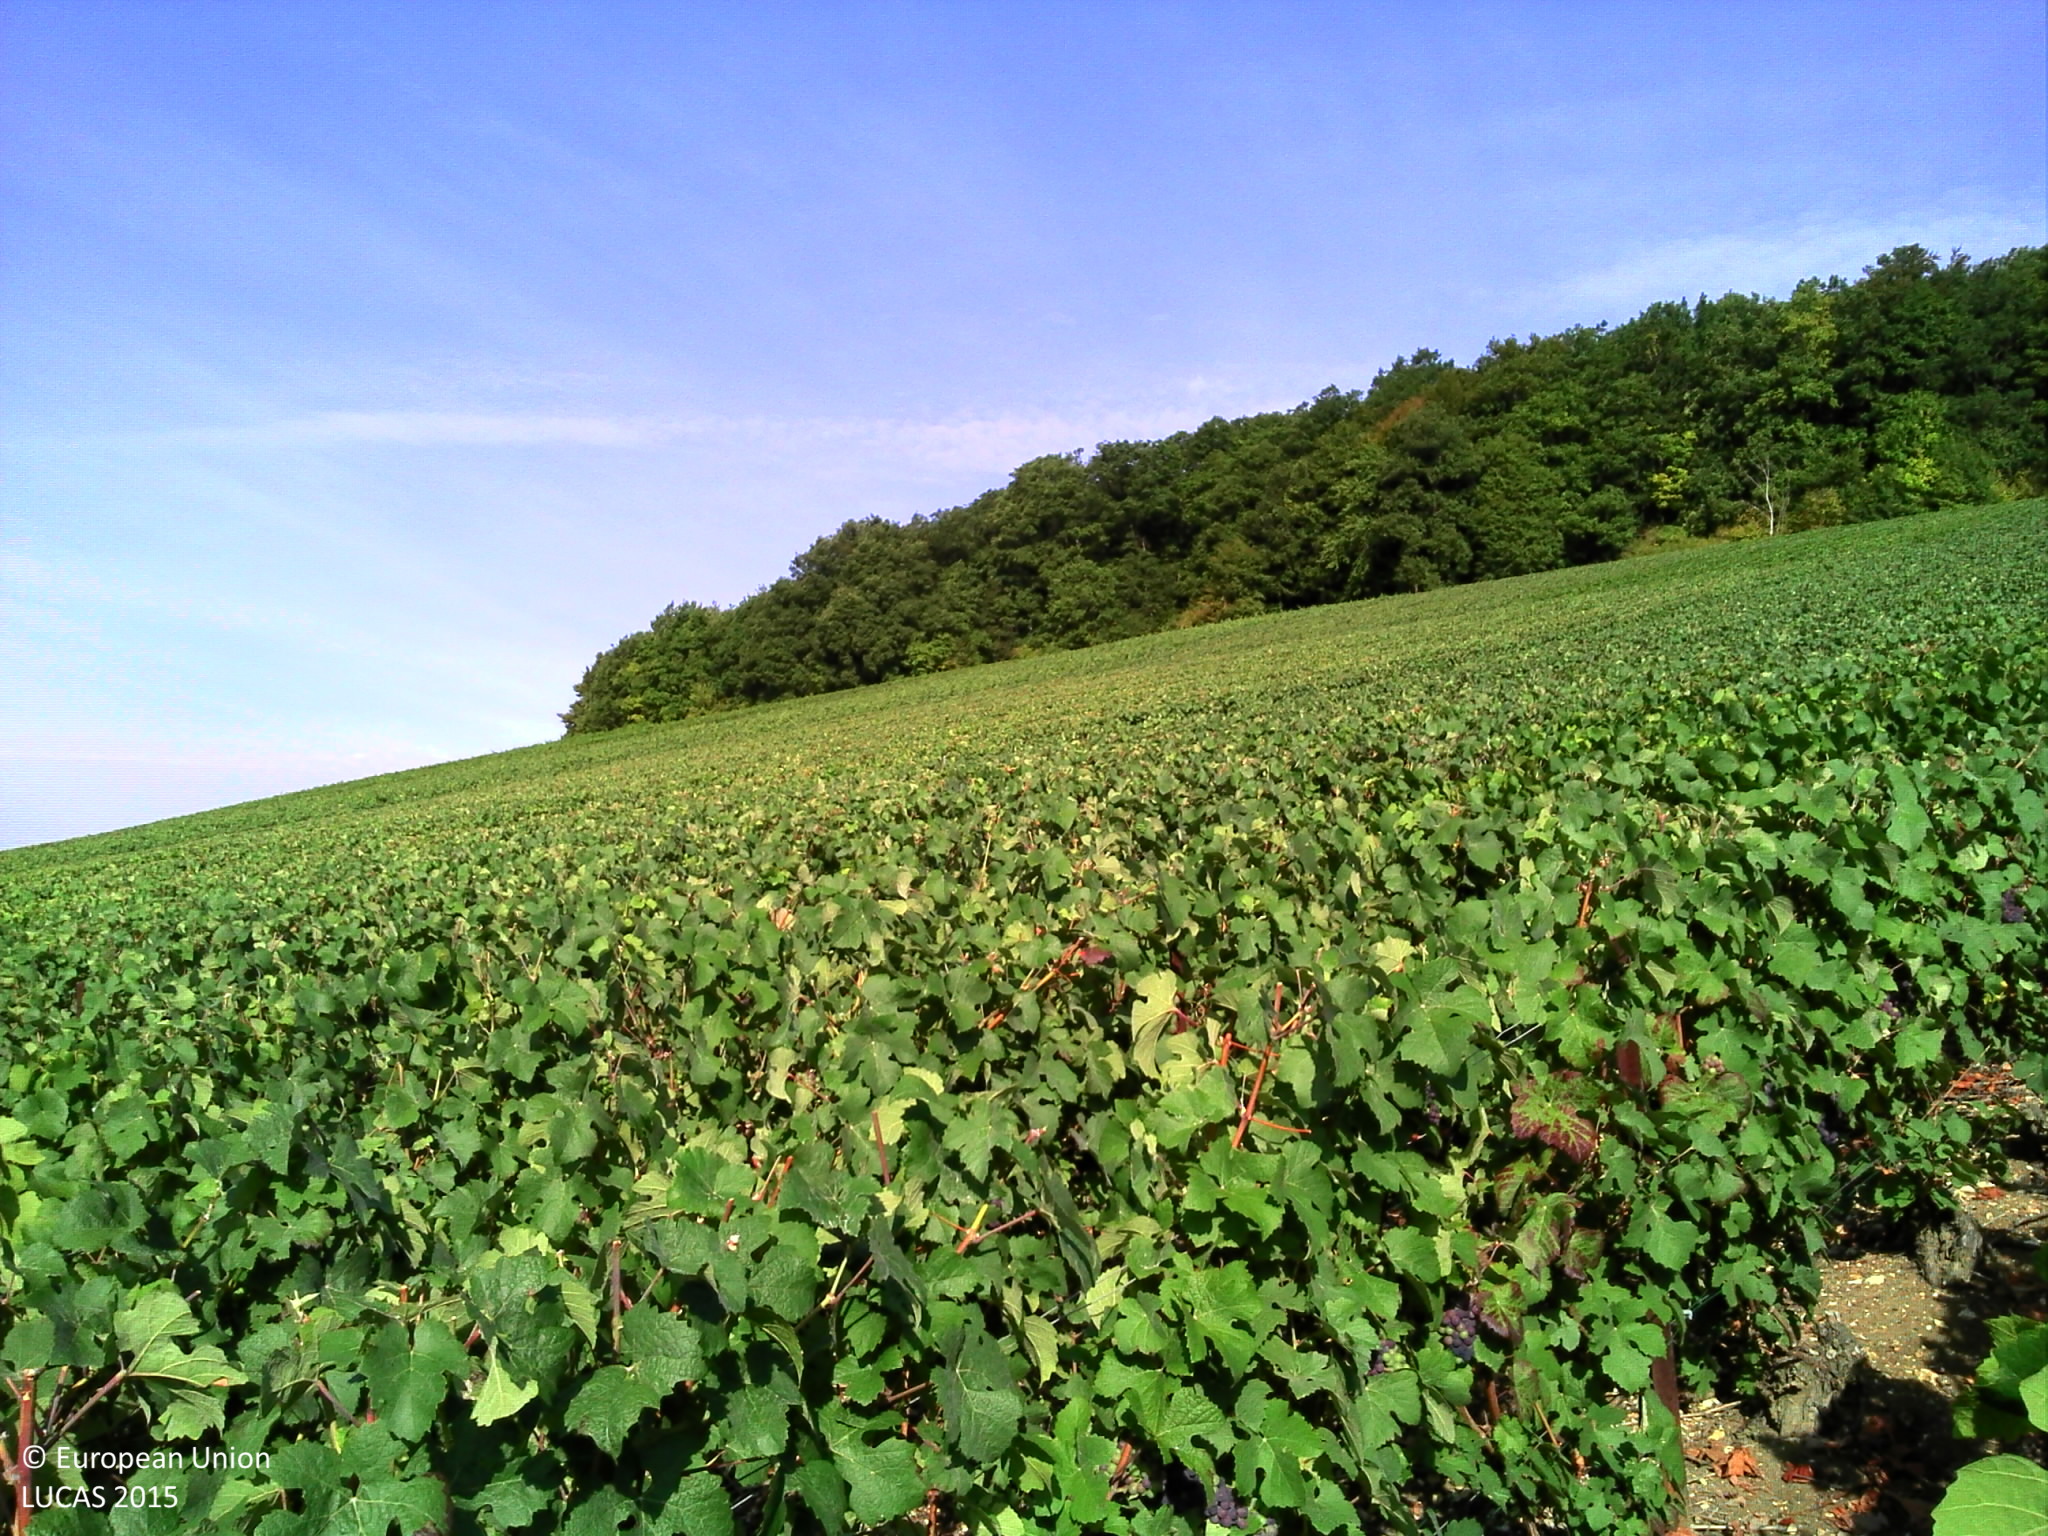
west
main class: Cropland
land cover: Vineyards
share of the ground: > 75 %
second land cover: Other bare soil
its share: > 75 %
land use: Agriculture (excluding fallow land and kitchen gardens)
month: August
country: FR
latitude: 49.0562
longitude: 3.7404
